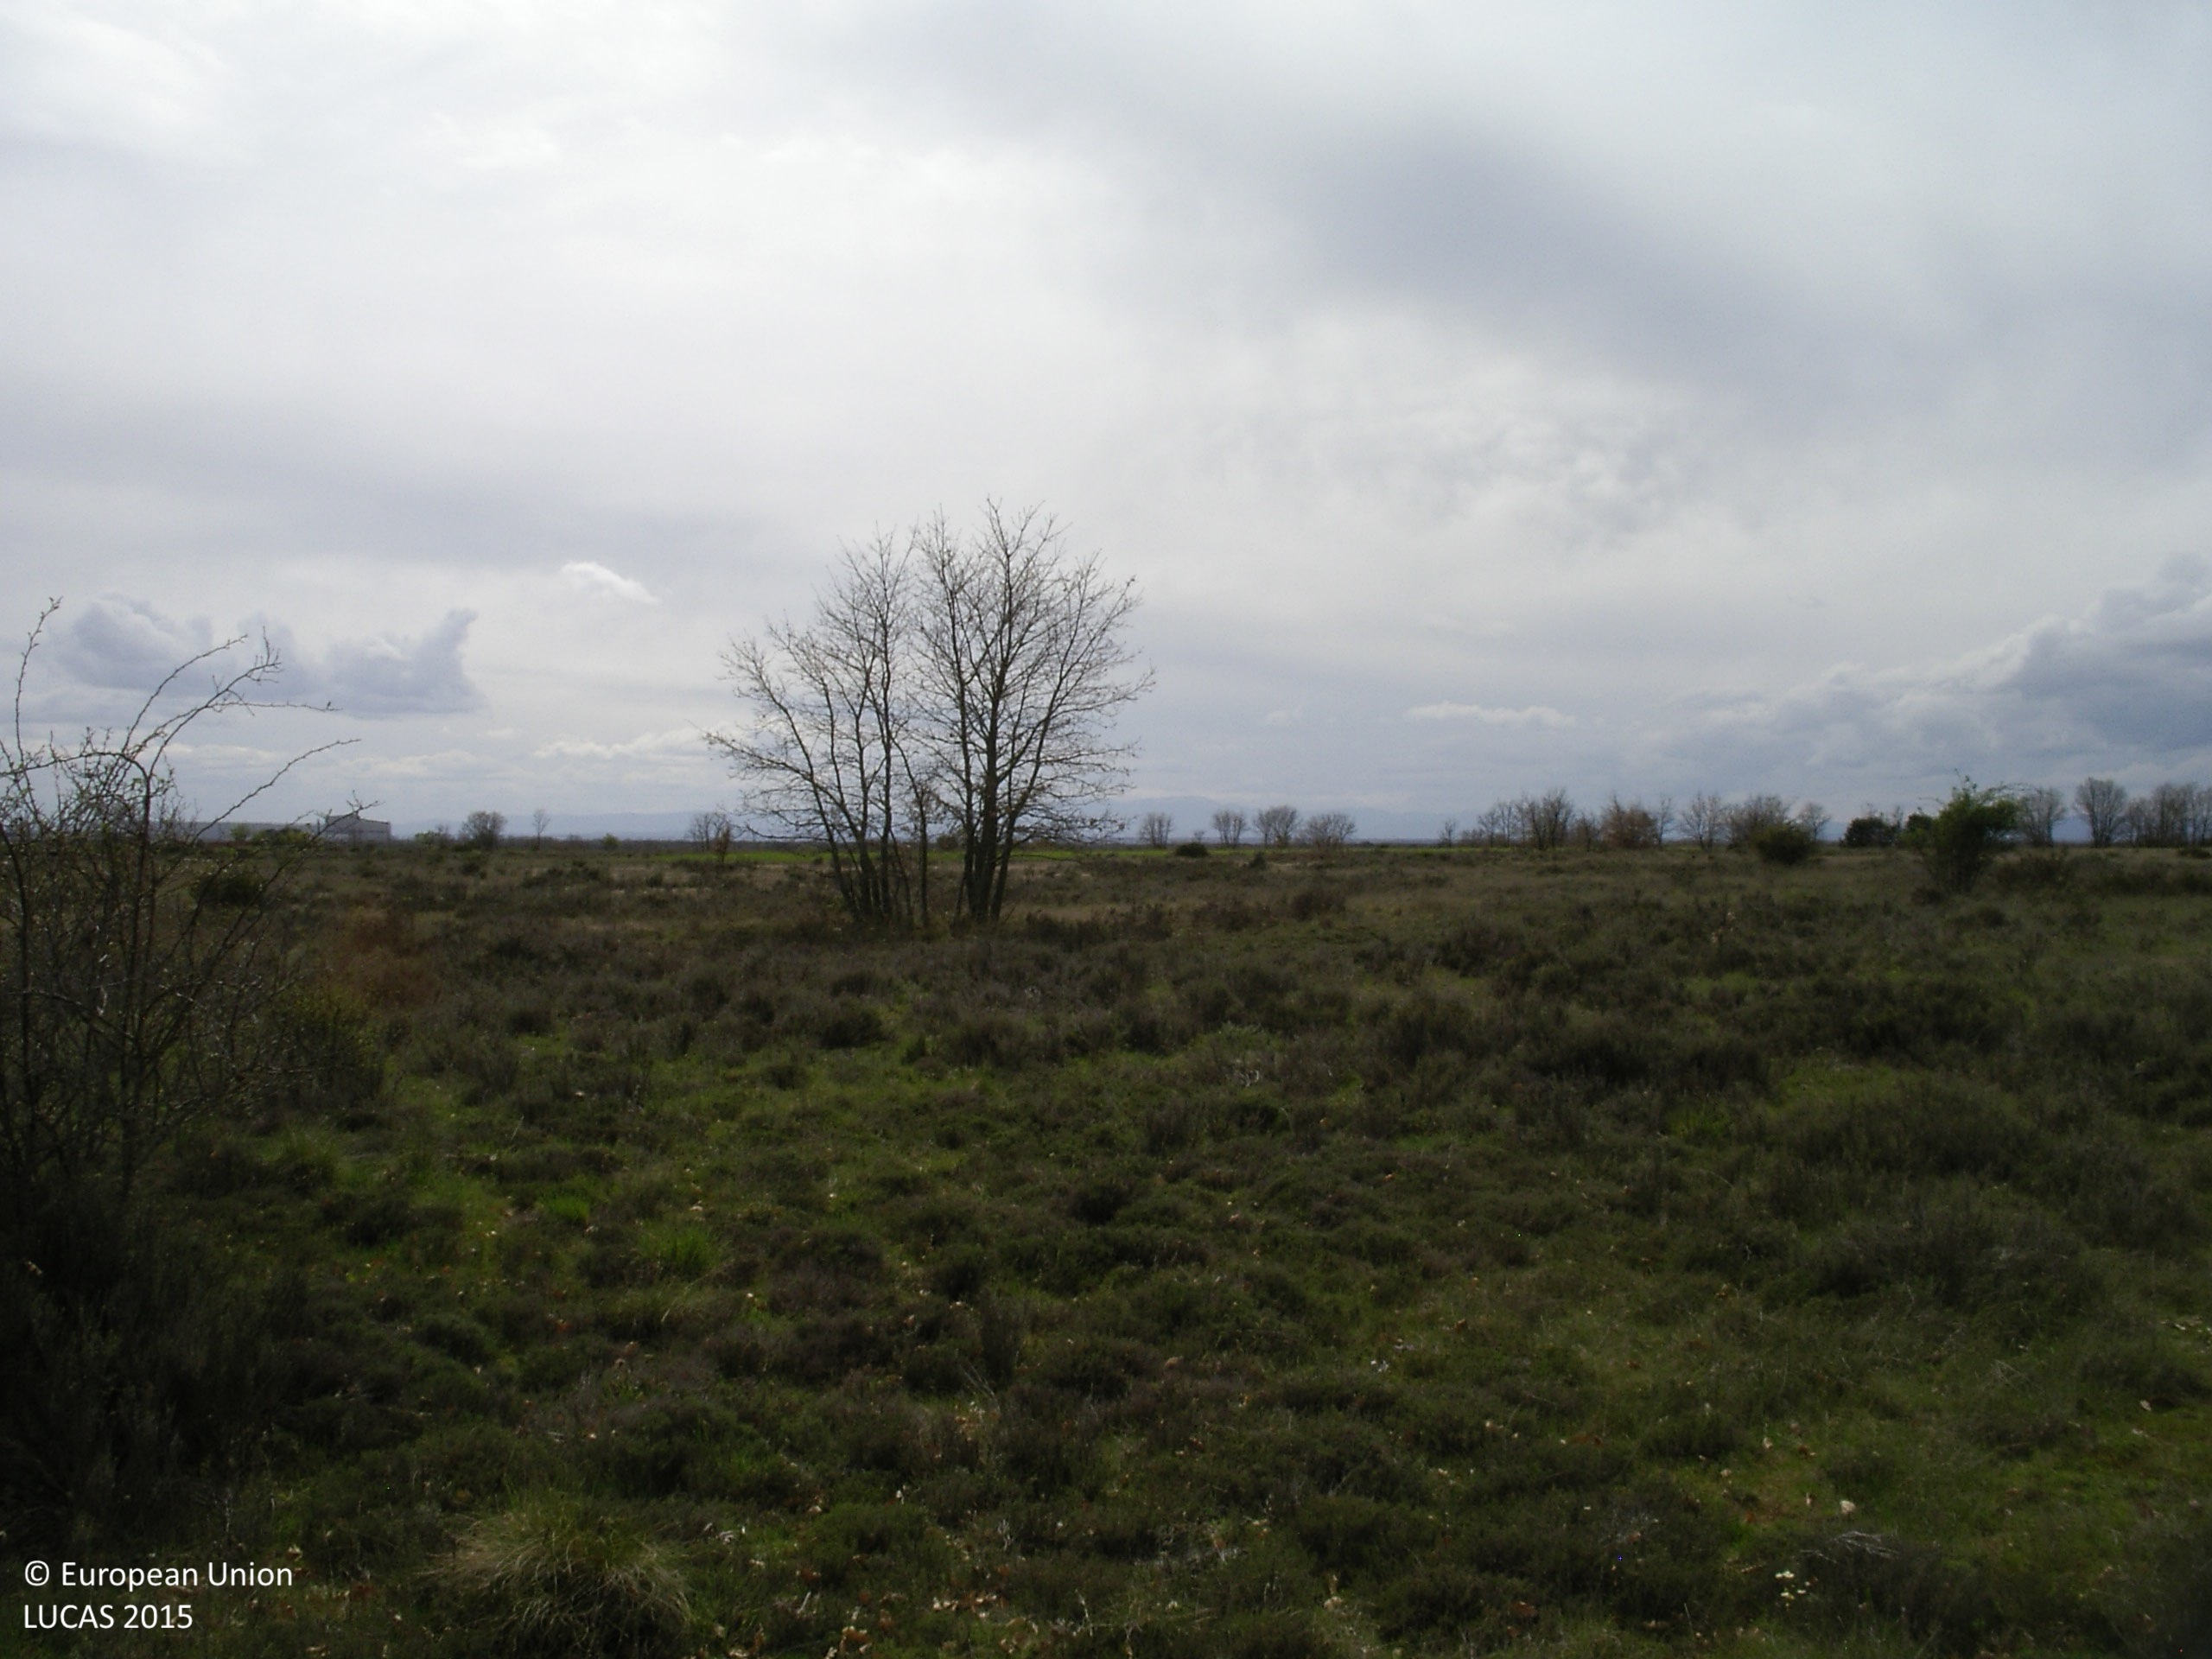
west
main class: Grassland
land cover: Grassland with sparse tree/shrub cover
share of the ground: > 75 %
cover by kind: herbaceous plants 90 %, broadleaved forest trees 5 %, shrubs 5 %
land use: Abandoned areas
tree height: > 5 m
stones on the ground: < 10 %
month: April
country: ES
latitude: 42.5551
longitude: -5.7258
